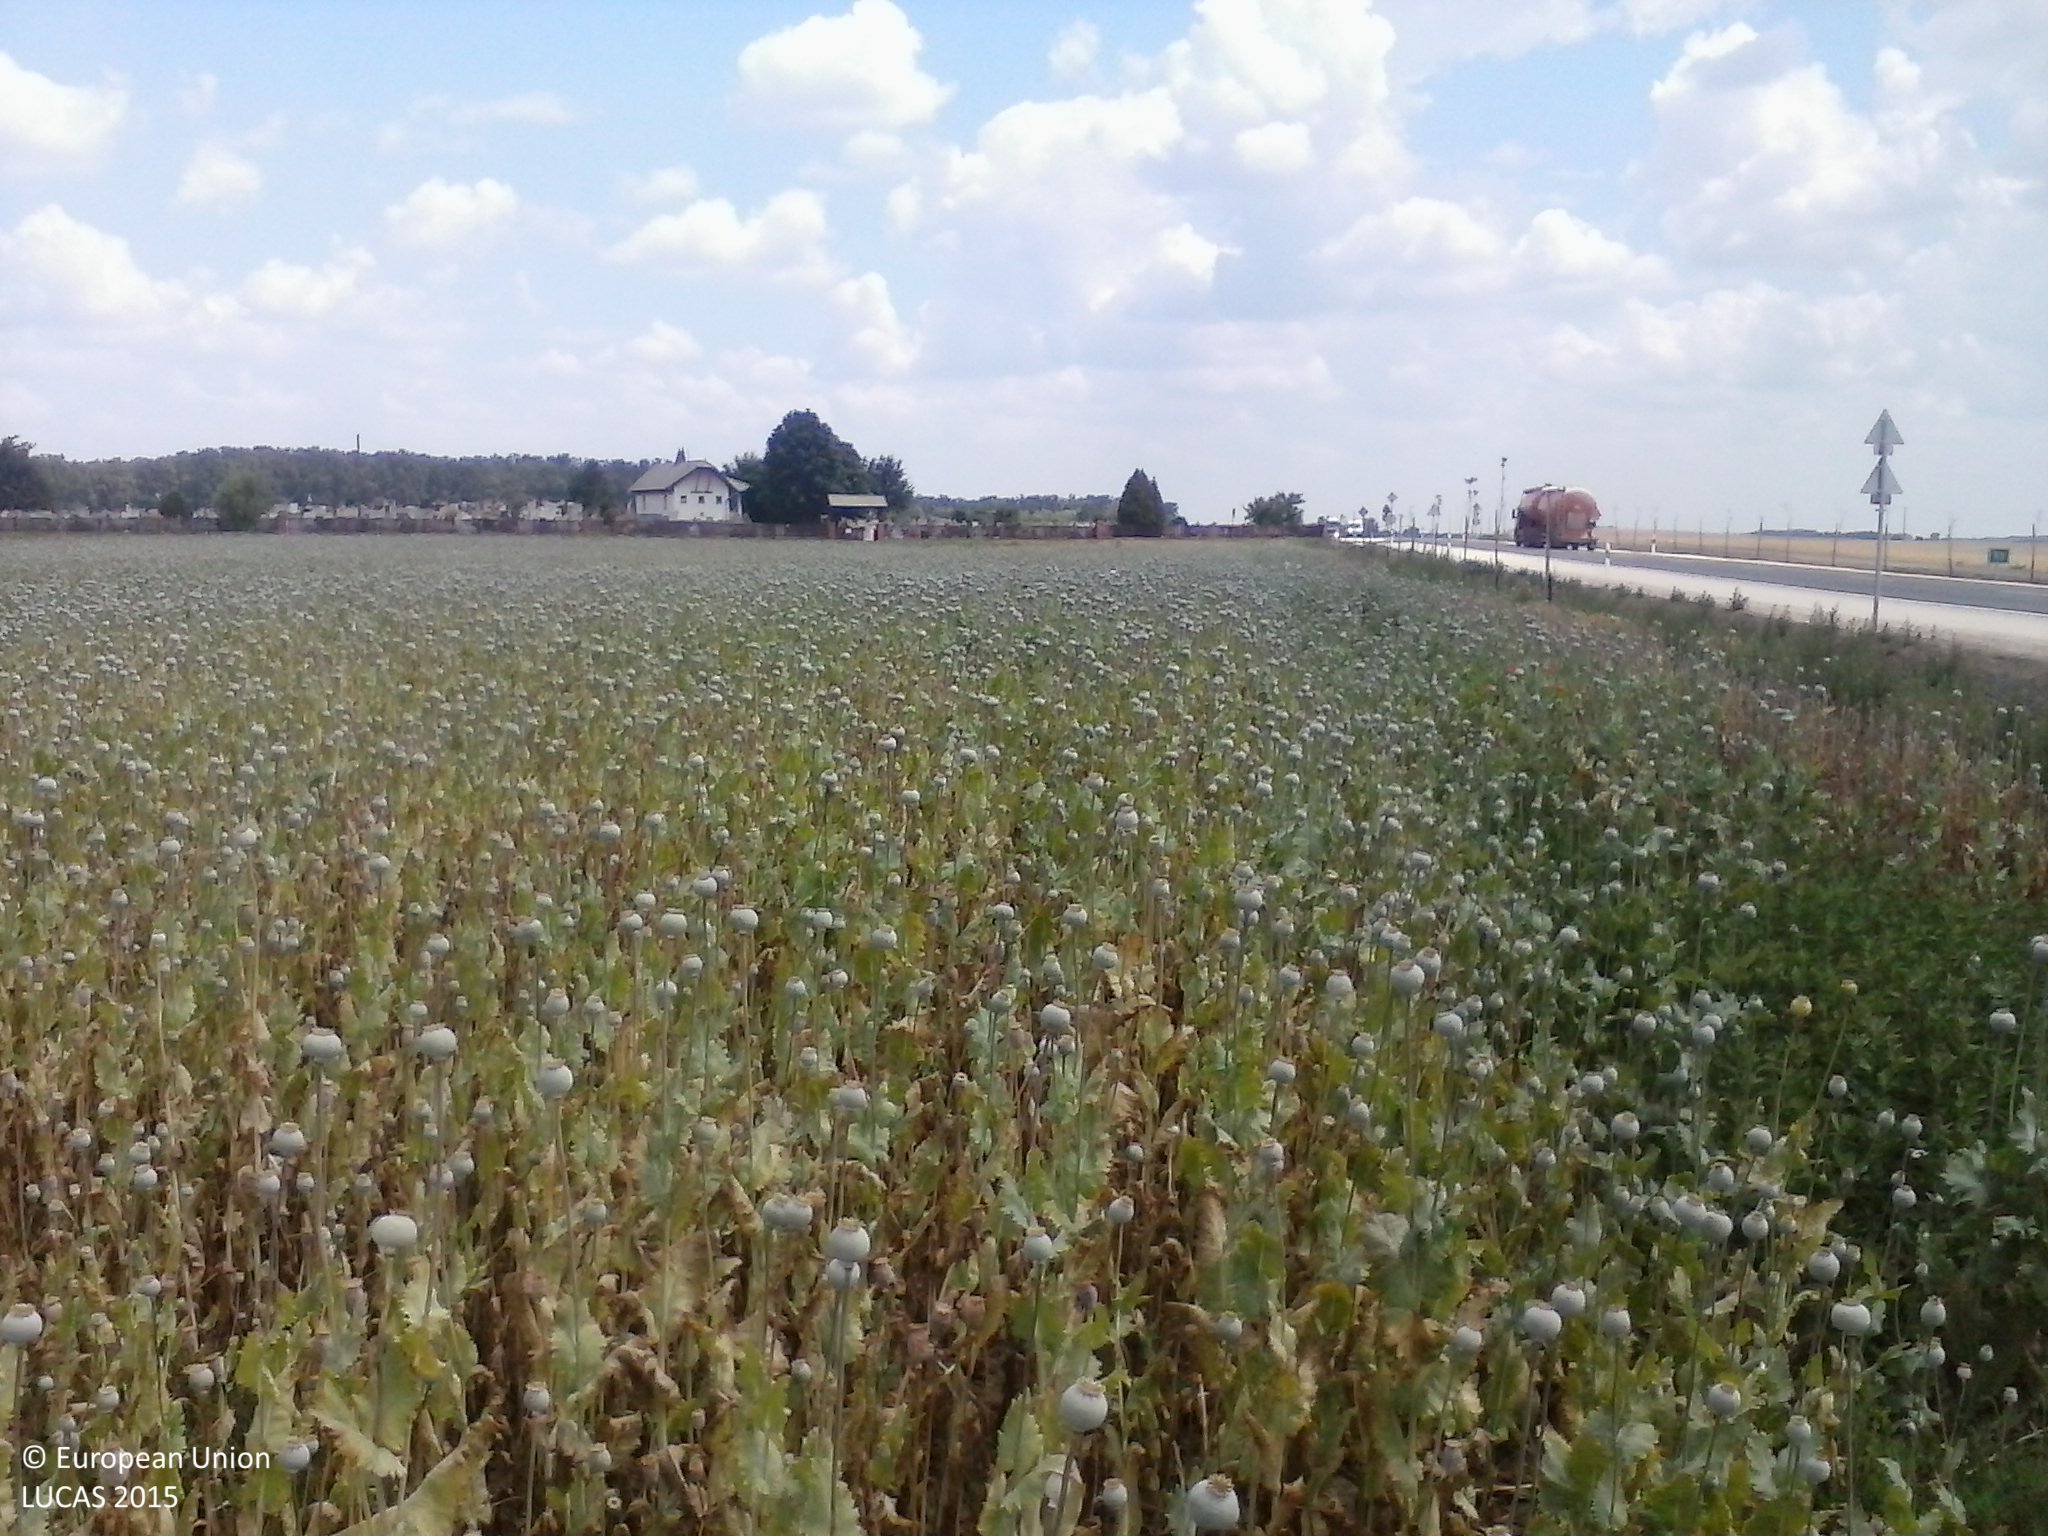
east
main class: Cropland
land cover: Other fibre and oleaginous crops
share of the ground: > 75 %
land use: Agriculture (excluding fallow land and kitchen gardens)
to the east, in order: Other fibre and oleaginous crops; Grass margins; Paved roads, cycling and walking lanes; Grassland without tree/shrub cover; Artificial constructions in urban areas
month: June
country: HU
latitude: 46.2718
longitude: 19.5020
